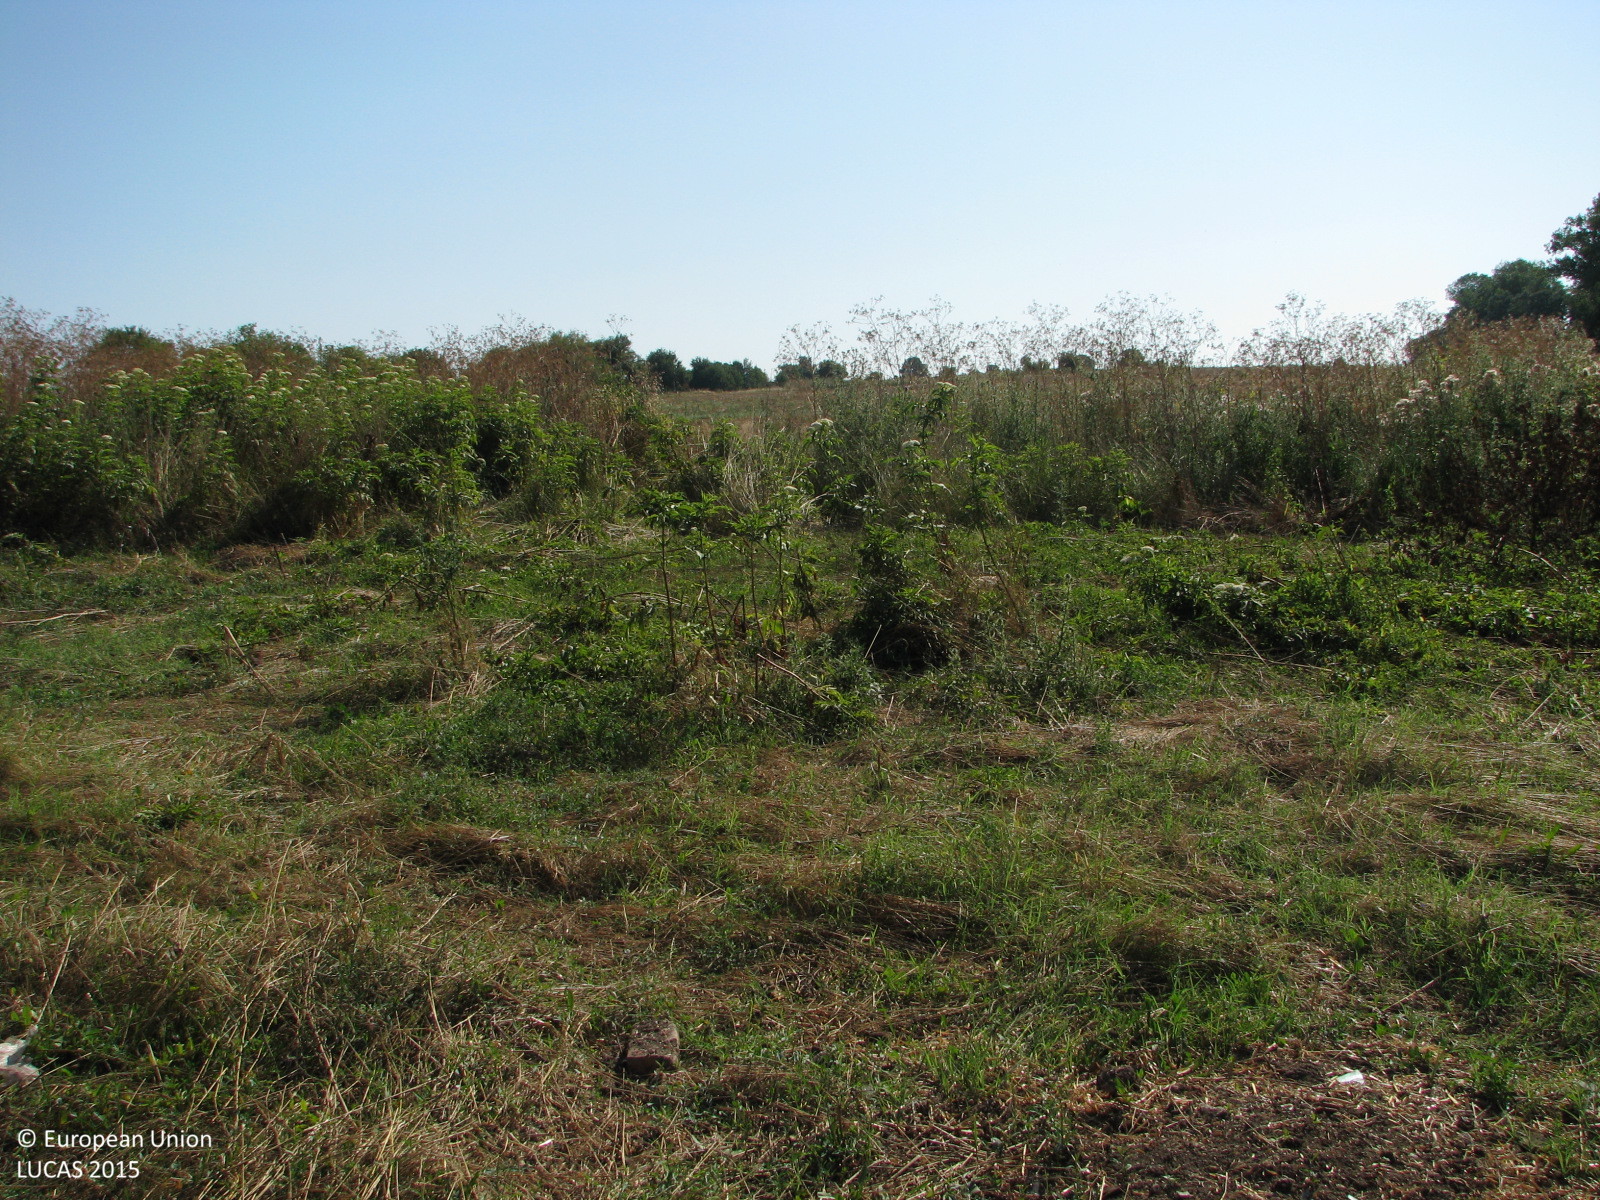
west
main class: Grassland
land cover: Spontaneously vegetated surfaces
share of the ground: > 75 %
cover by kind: herbaceous plants 100 %
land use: Agriculture (excluding fallow land and kitchen gardens)
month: July
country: BG
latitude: 42.2686
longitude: 26.9152
